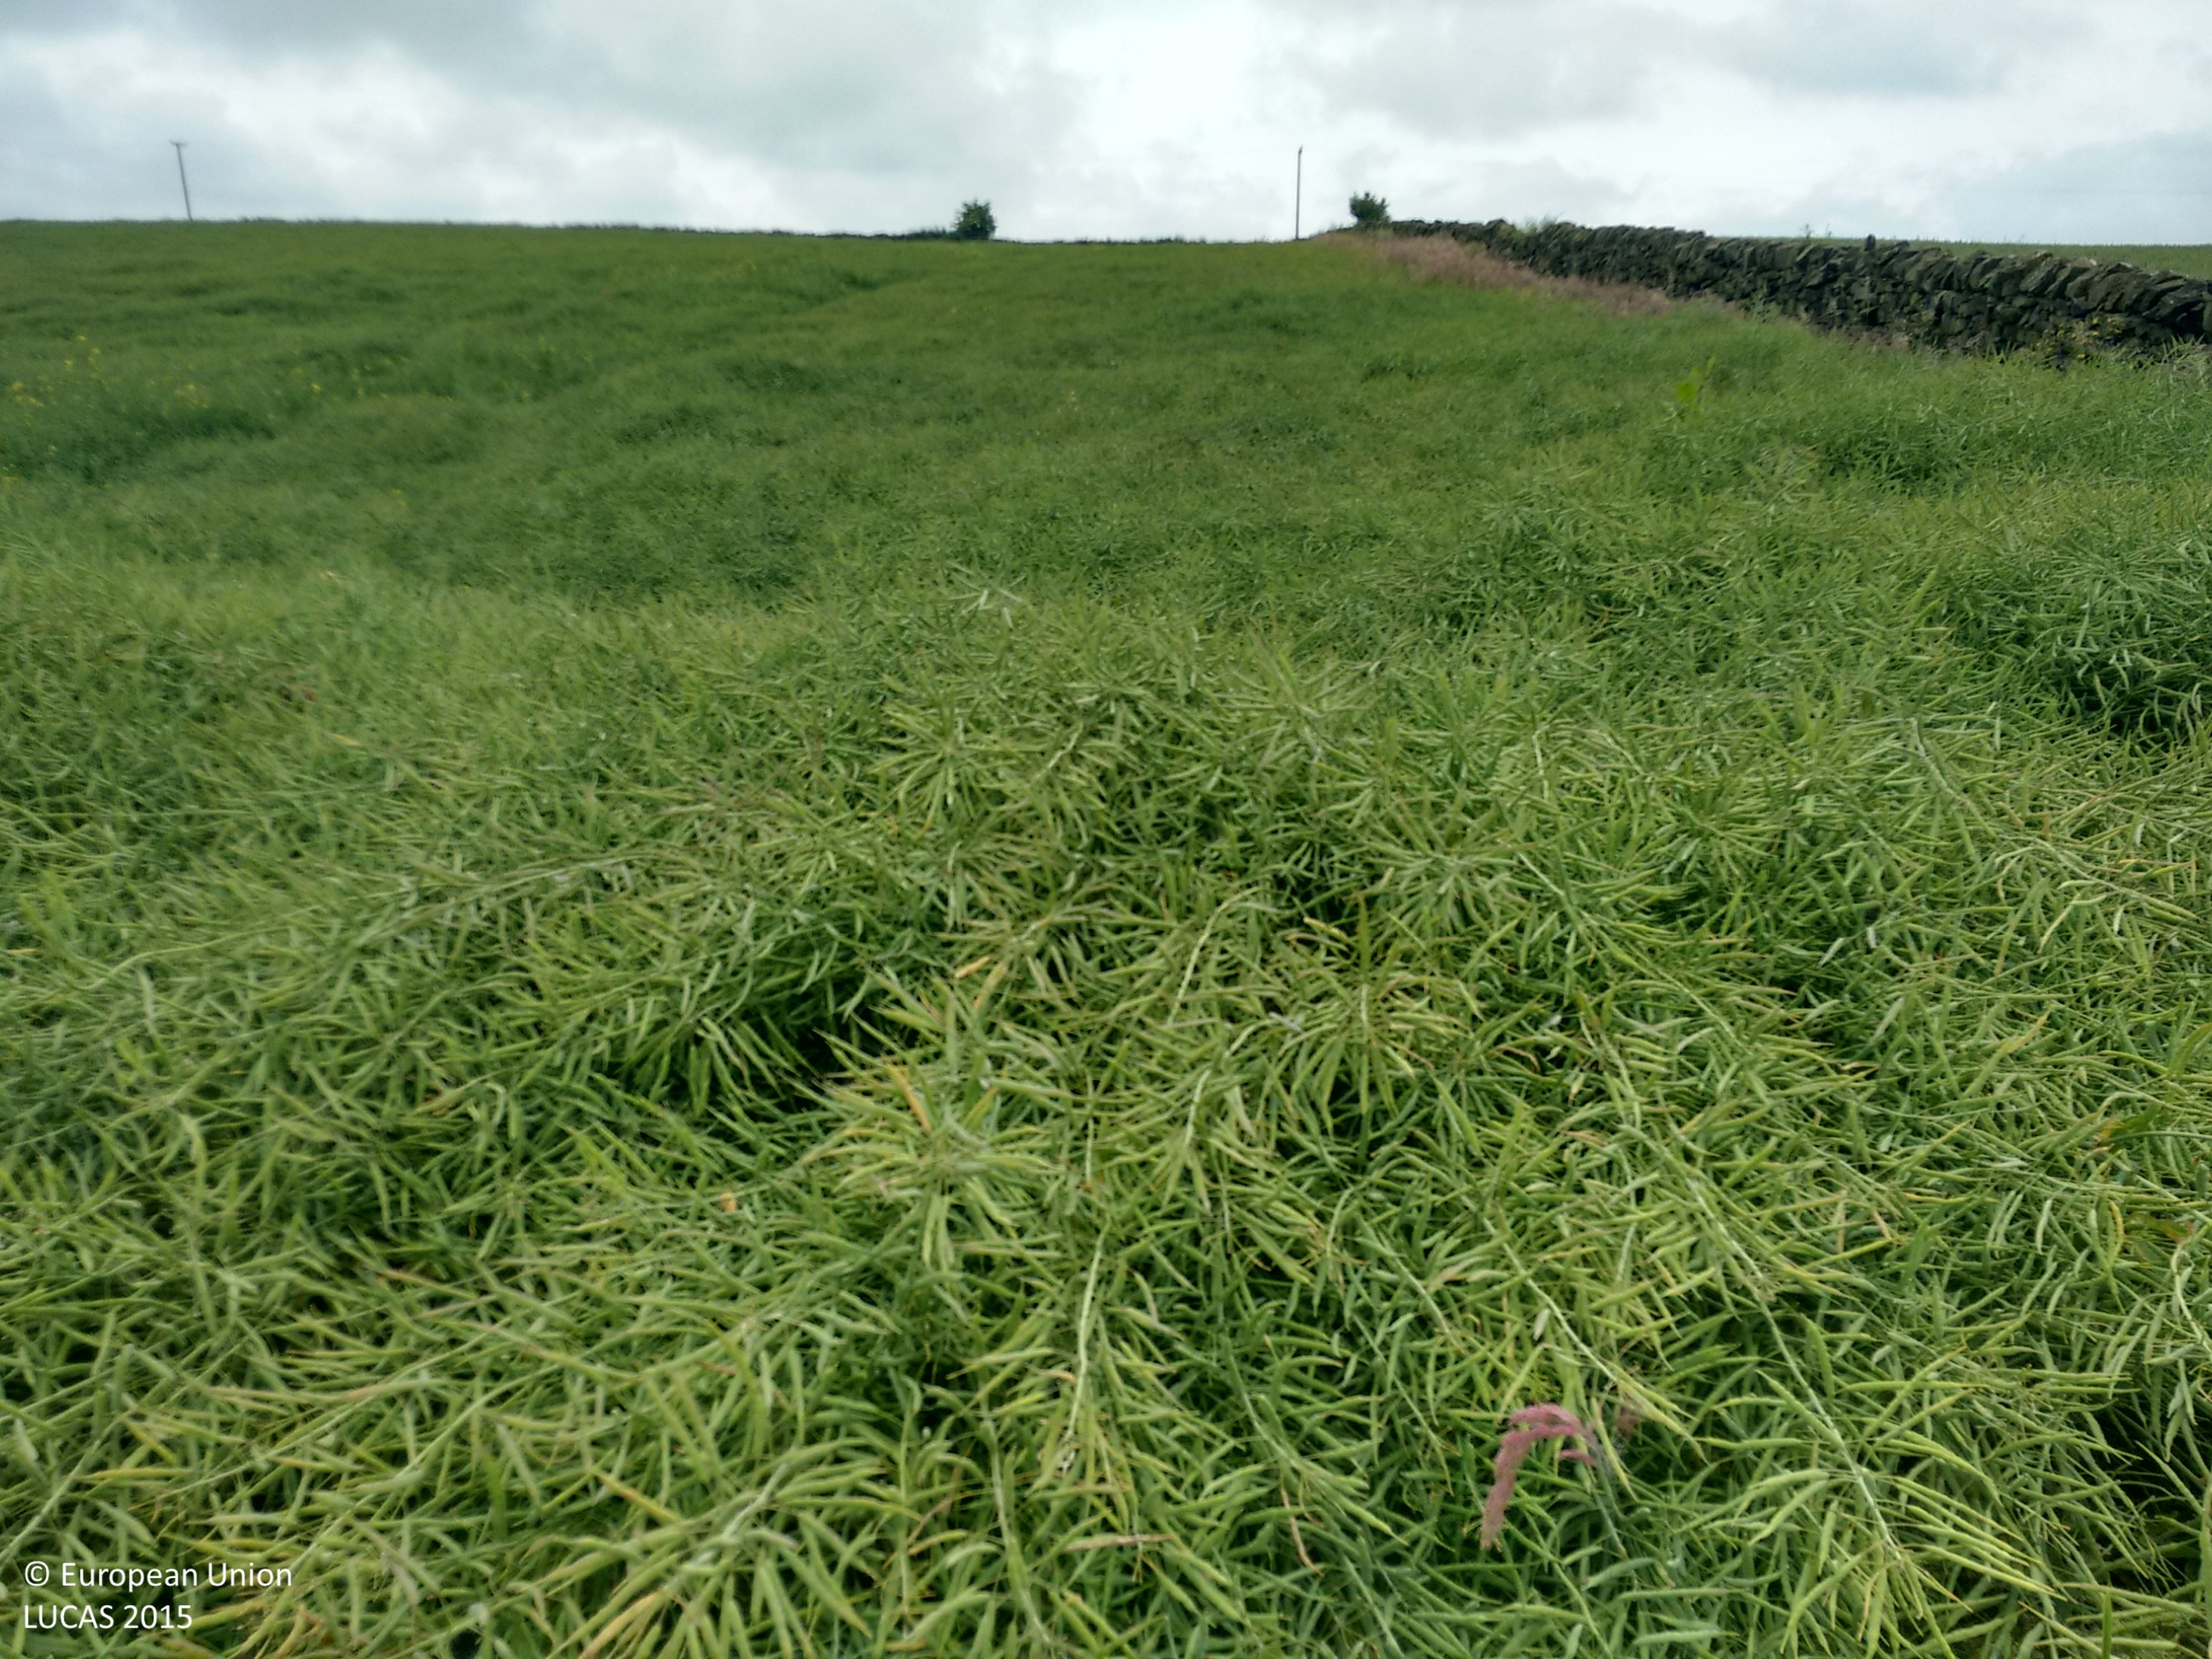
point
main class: Cropland
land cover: Rape and turnip rape
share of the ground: > 75 %
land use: Agriculture (excluding fallow land and kitchen gardens)
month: June
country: GB
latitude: 53.2707
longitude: -1.4911
